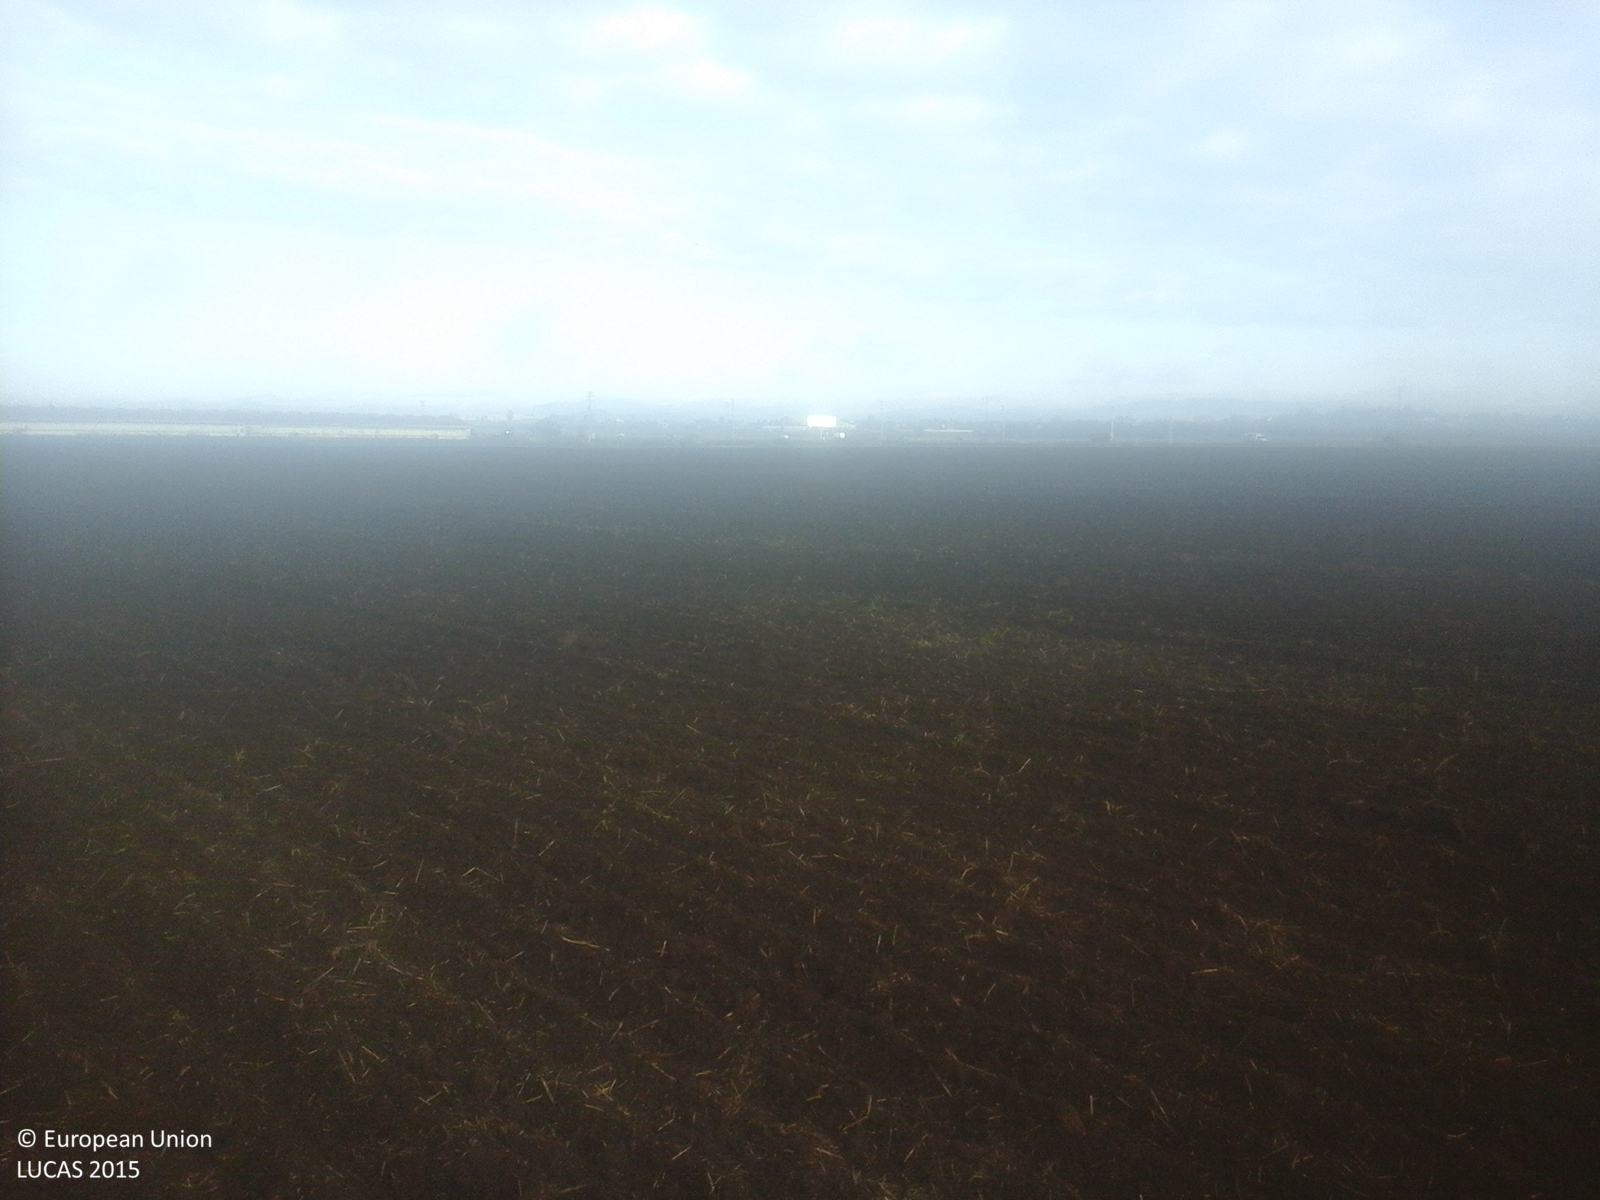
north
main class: Cropland
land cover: Common wheat
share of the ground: < 10 %
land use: Agriculture (excluding fallow land and kitchen gardens)
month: October
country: RO
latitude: 45.0129
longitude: 25.8514
